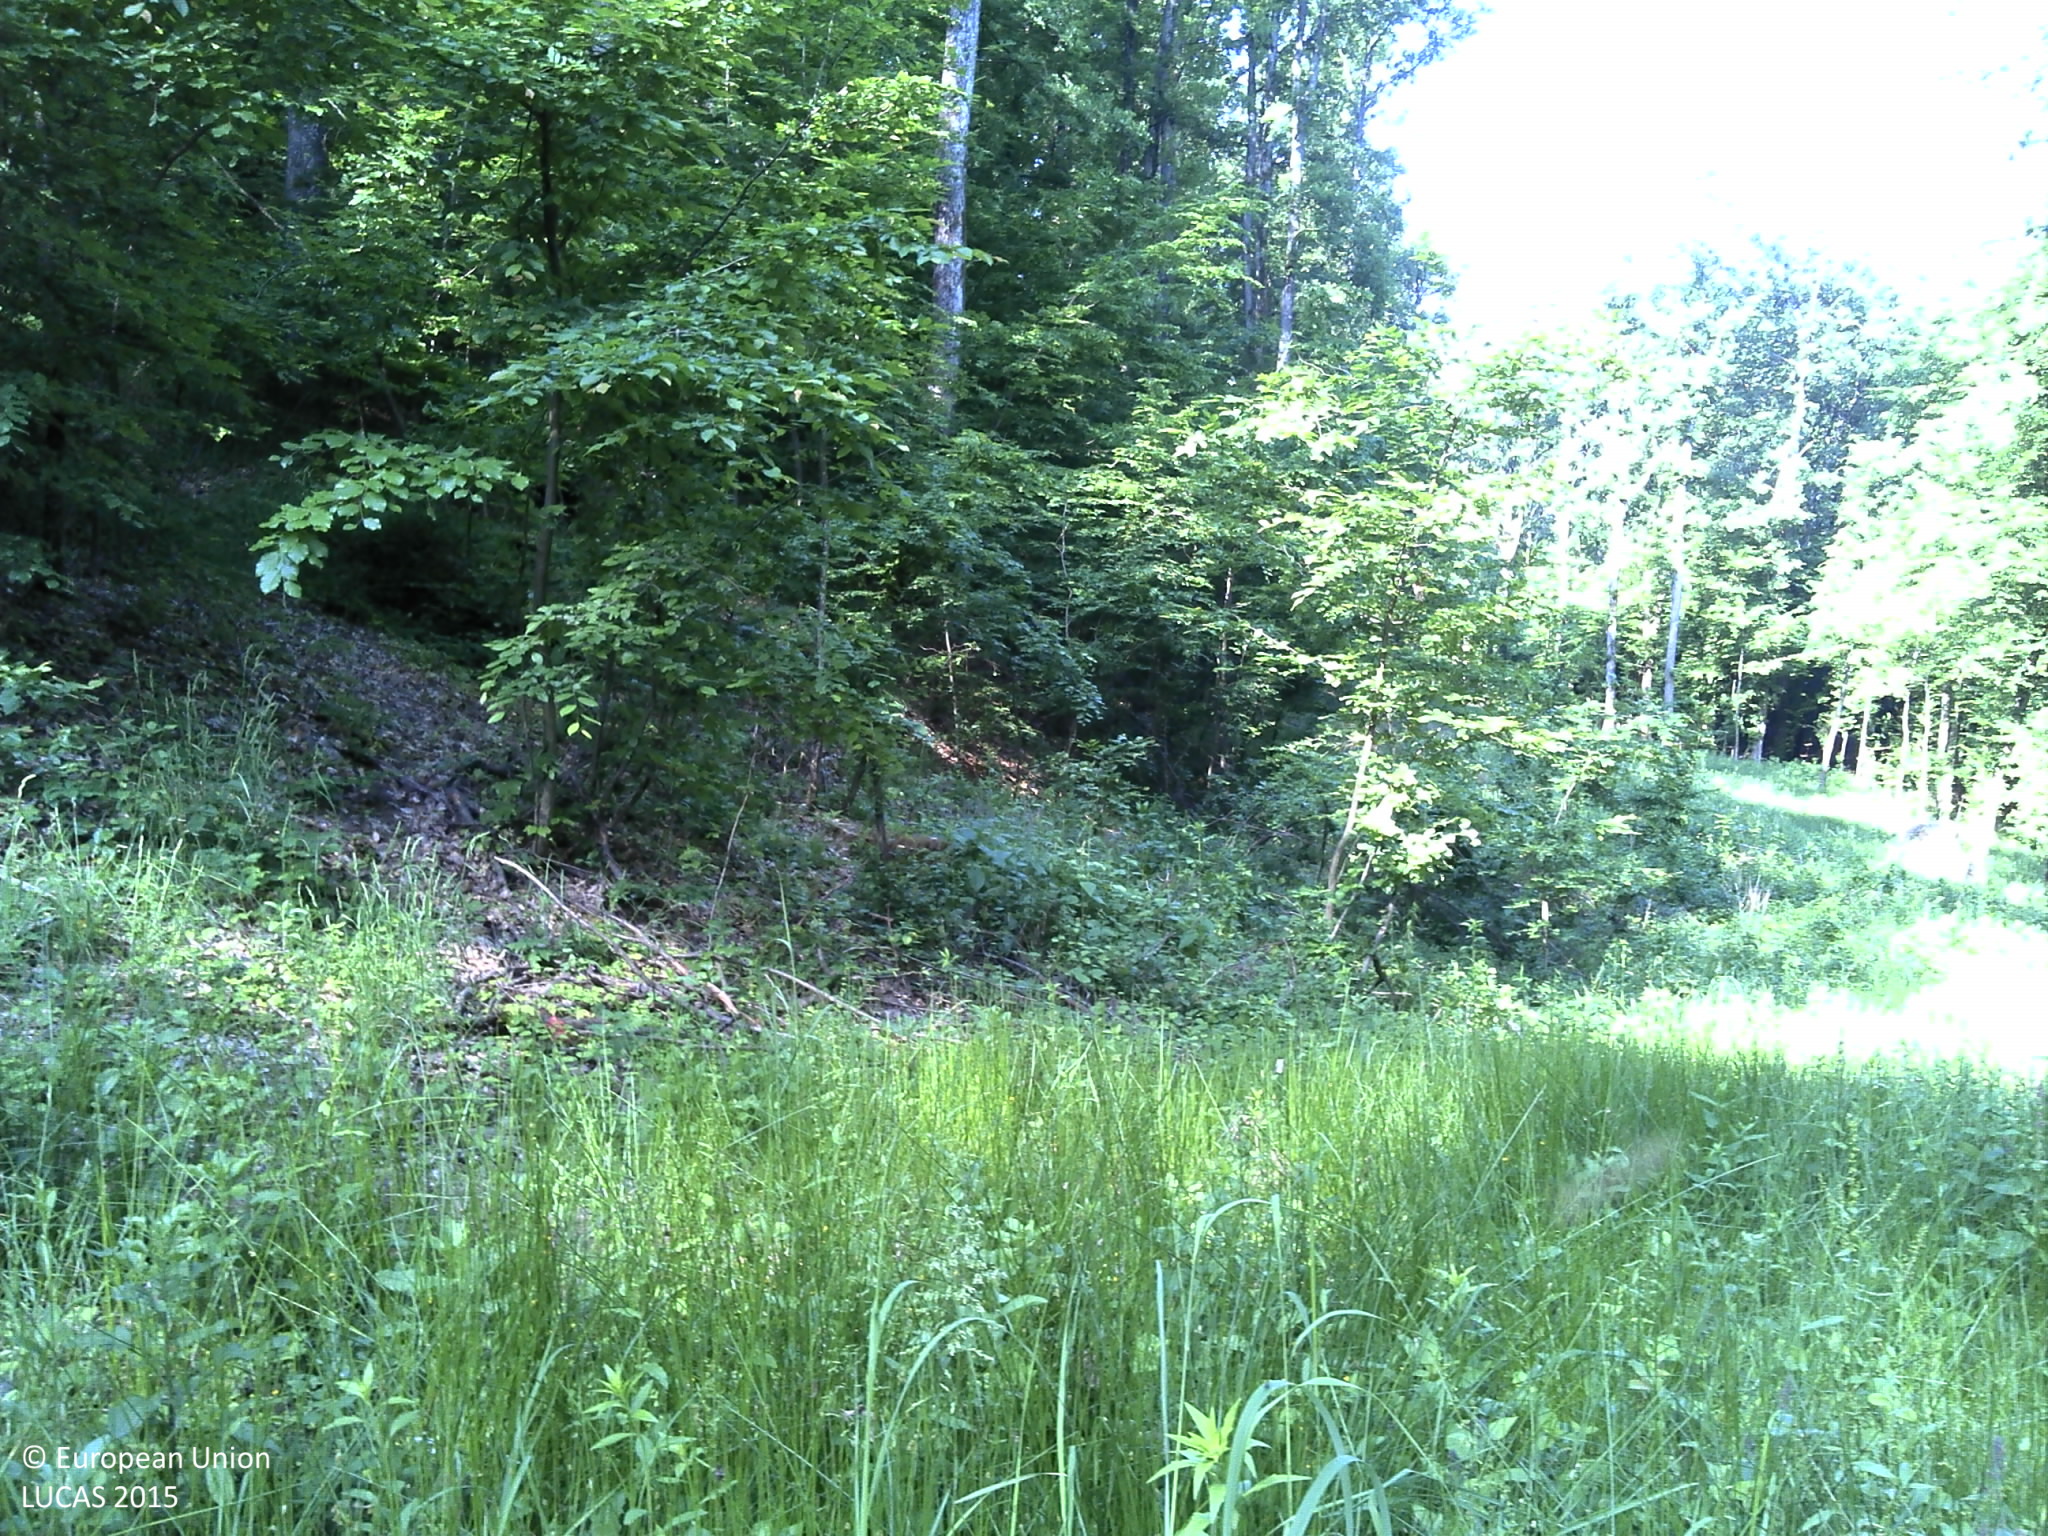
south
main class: Woodland
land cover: Broadleaved woodland
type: acidophilous oak and oak-birch forest
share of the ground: > 75 %
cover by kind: broadleaved forest trees 100 %
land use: Forestry
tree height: > 5 m
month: May
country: HR
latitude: 45.4882
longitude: 18.0263
